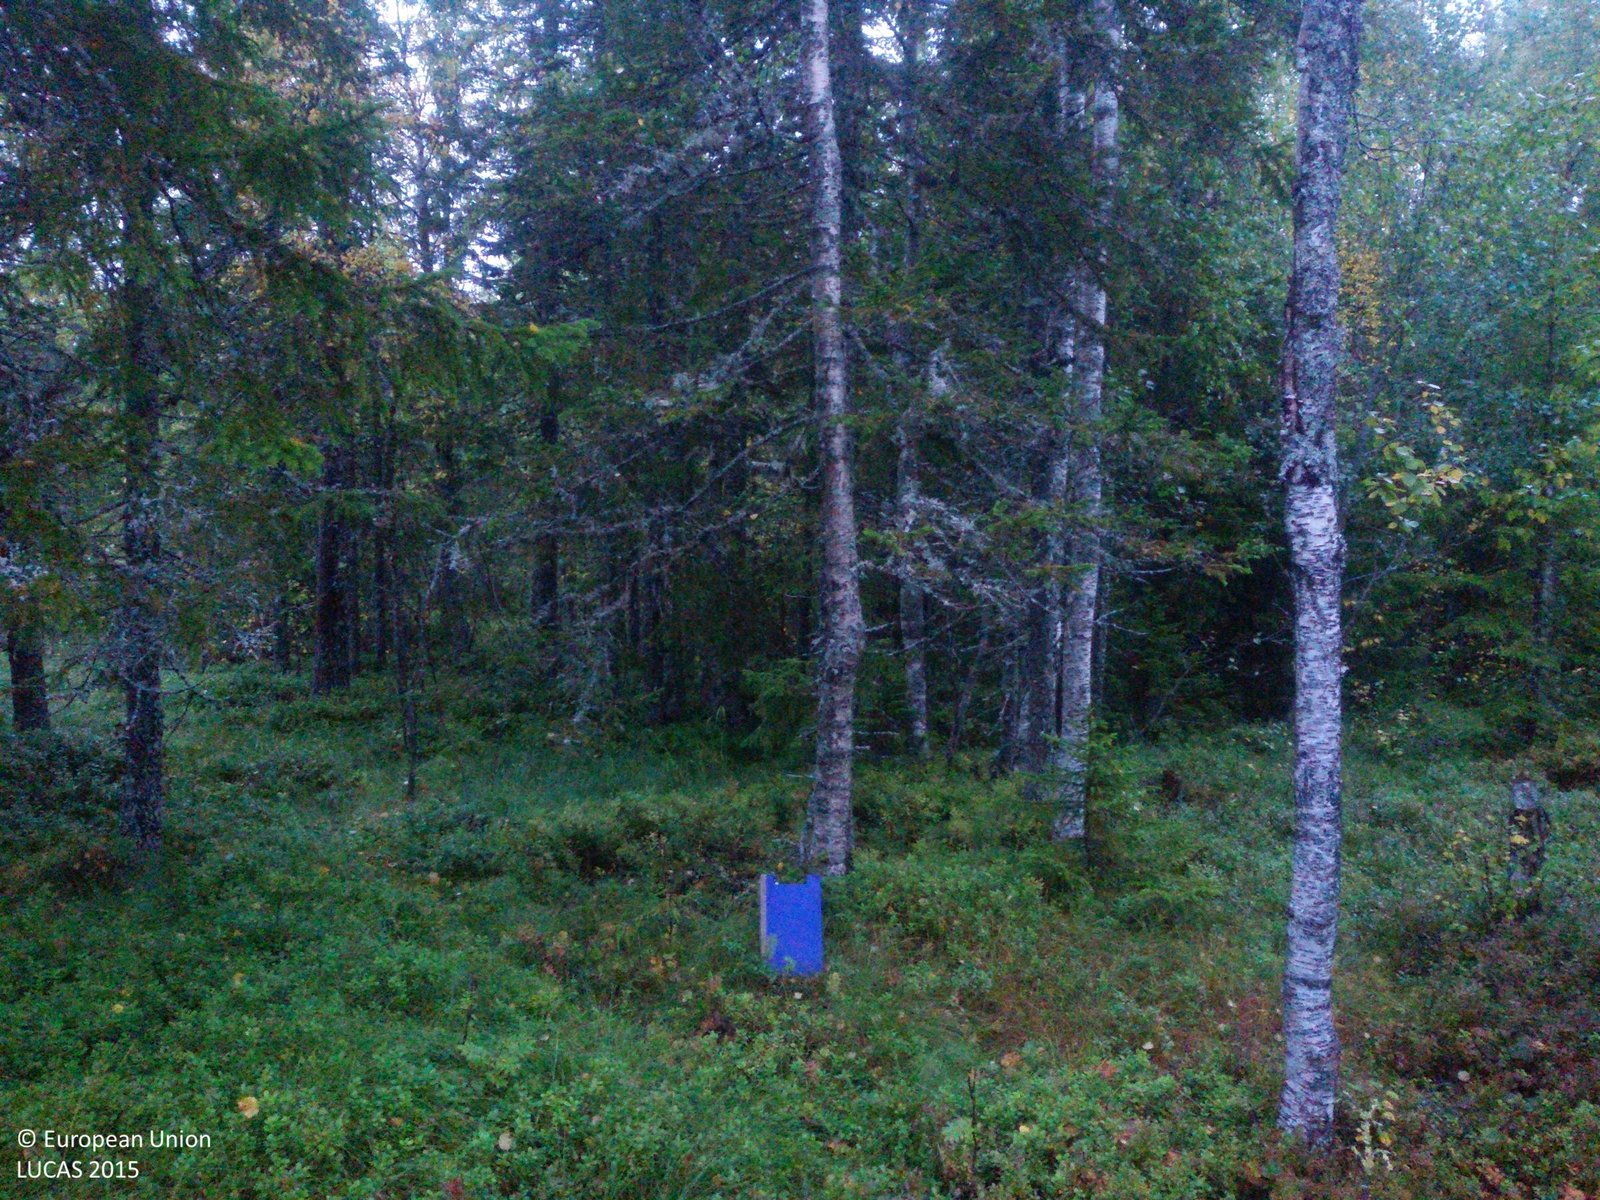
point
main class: Woodland
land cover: Spruce dominated mixed woodland
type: boreal forest
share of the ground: > 75 %
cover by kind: coniferous forest trees 40 %, broadleaved forest trees 30 %, herbaceous plants 20 %, lichens and mosses 10 %
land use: Forestry
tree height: > 5 m
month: September
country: SE
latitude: 60.9810
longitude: 14.2928
